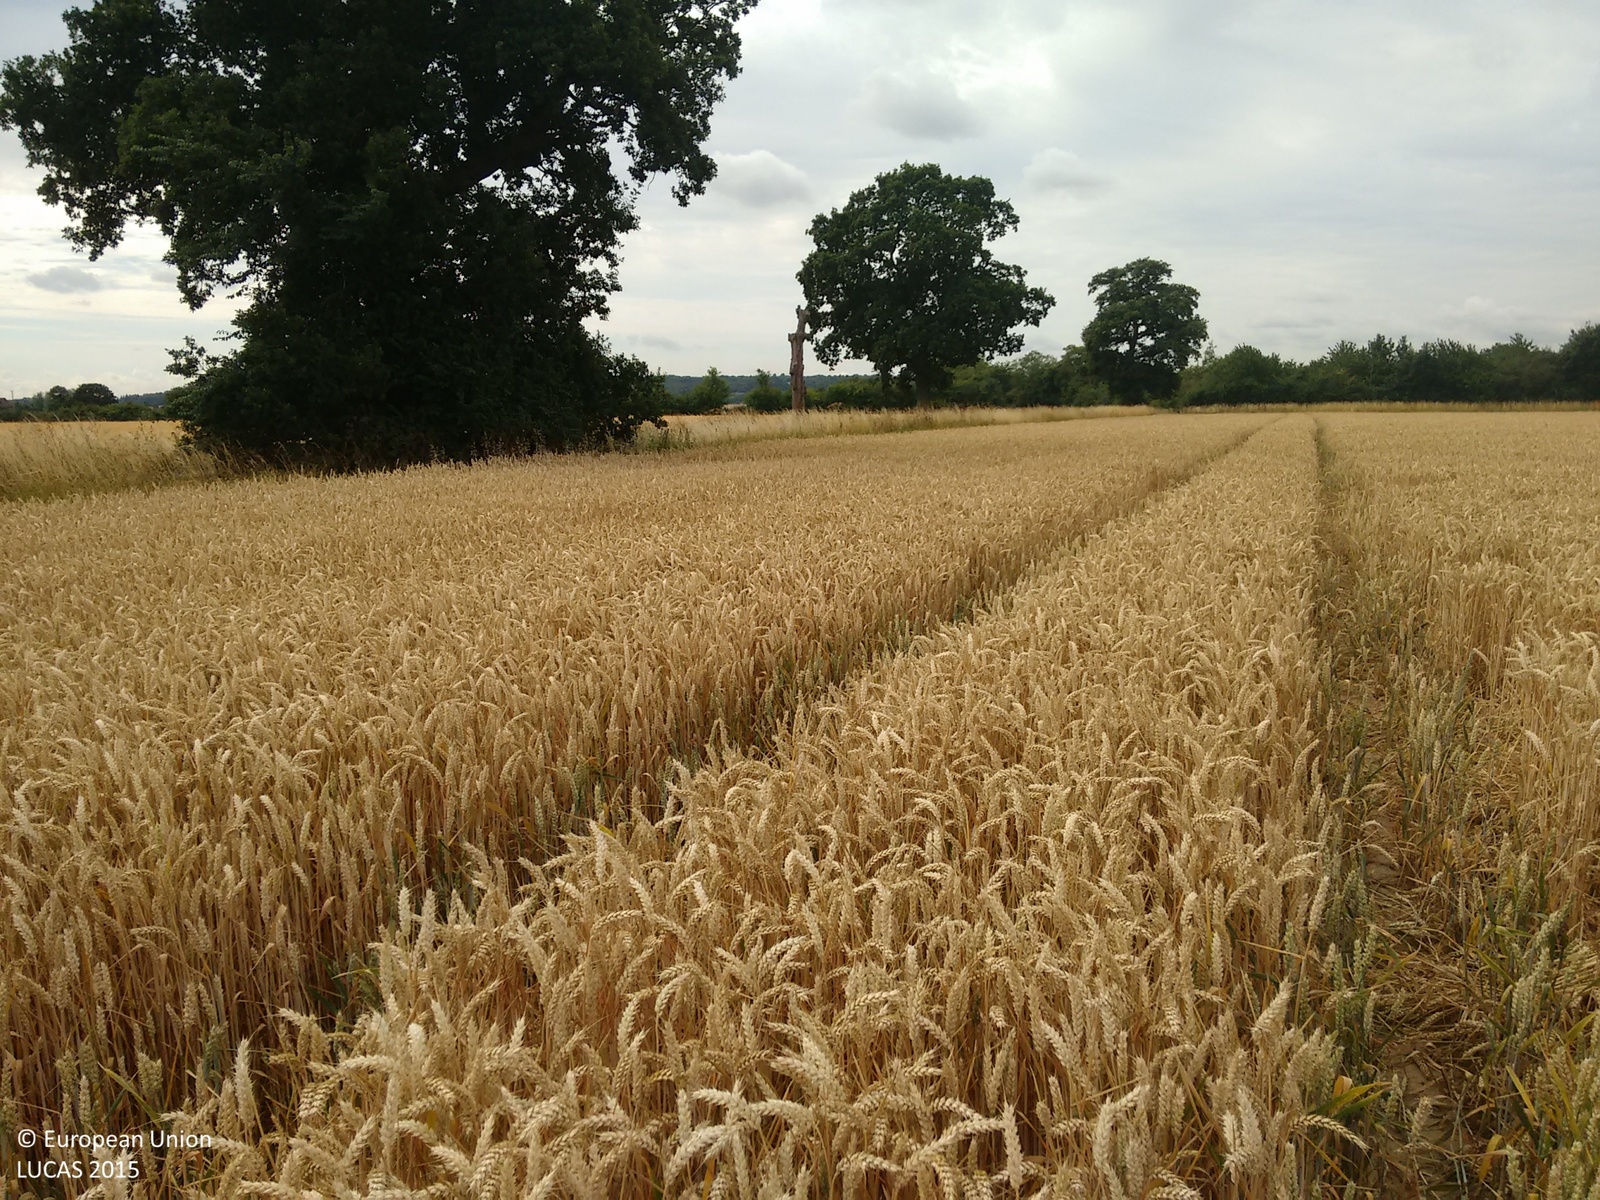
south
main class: Cropland
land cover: Common wheat
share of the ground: > 75 %
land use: Agriculture (excluding fallow land and kitchen gardens)
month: July
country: GB
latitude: 51.7659
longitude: 0.5687
